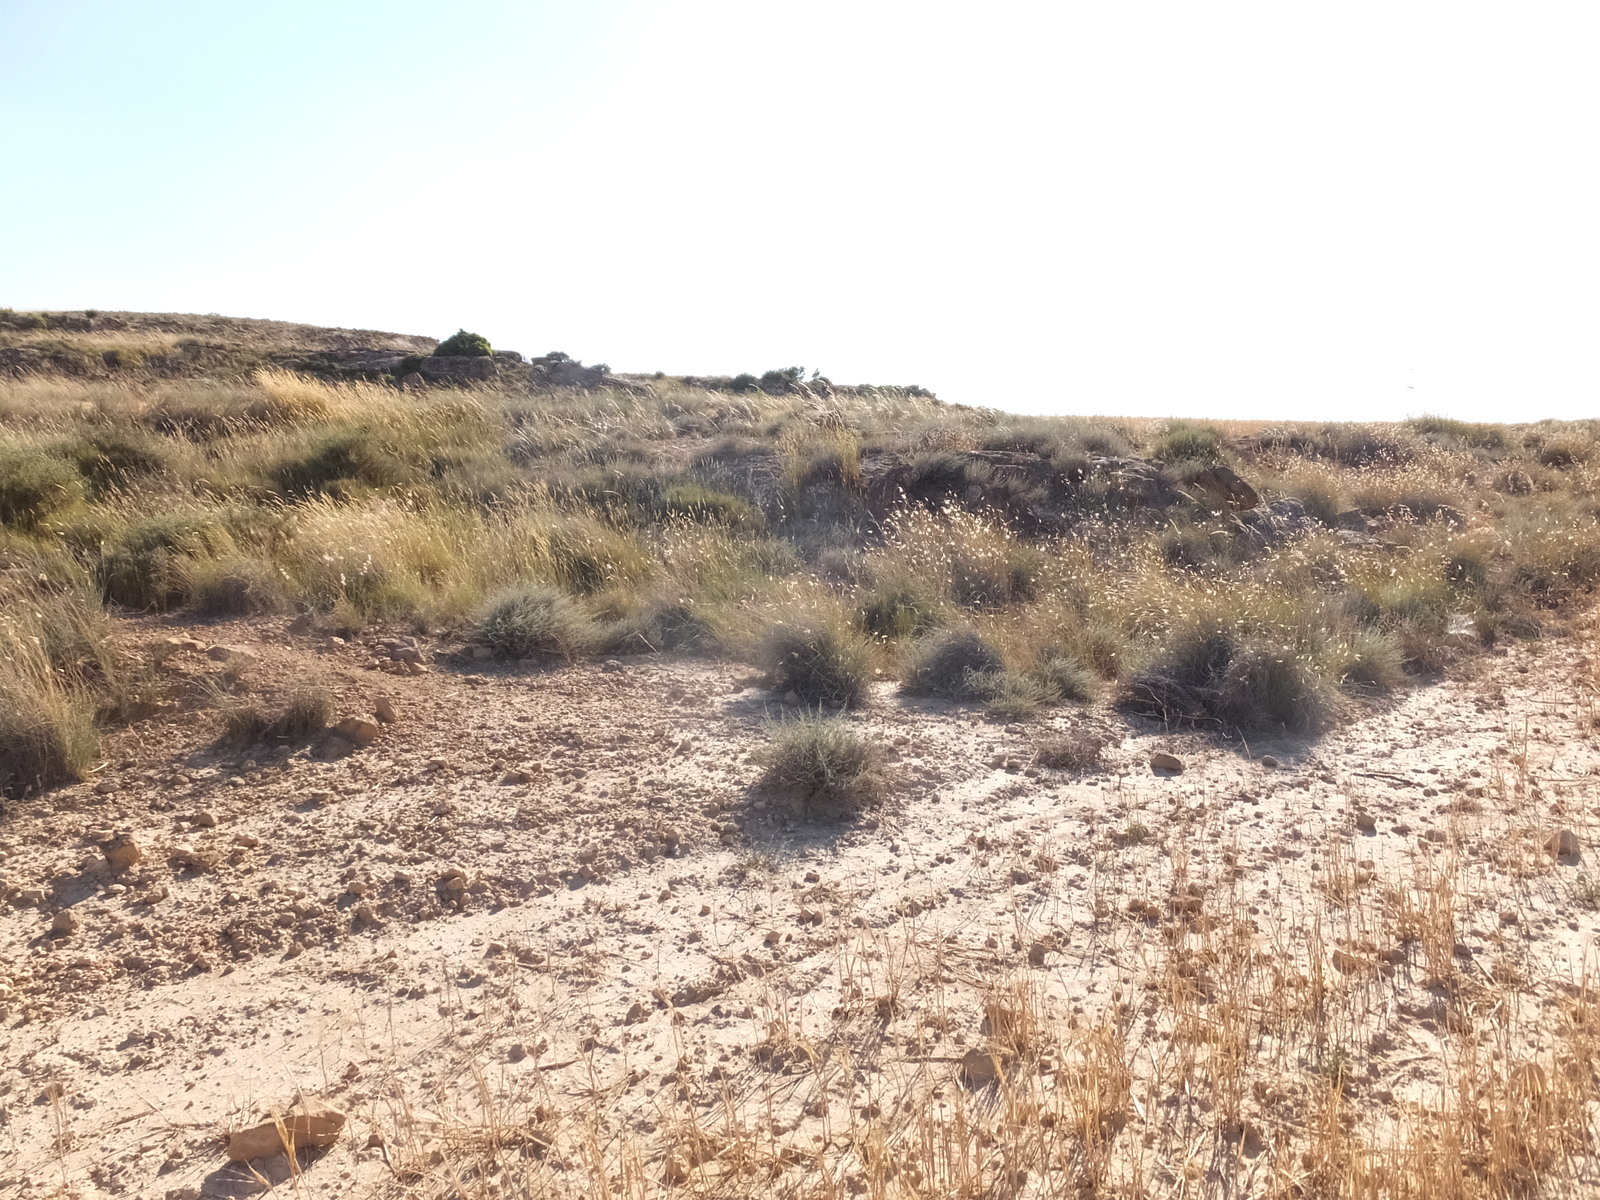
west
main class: Cropland
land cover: Barley
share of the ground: > 75 %
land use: Agriculture (excluding fallow land and kitchen gardens)
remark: Harvested field
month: June
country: ES
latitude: 41.2014
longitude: -0.2809
